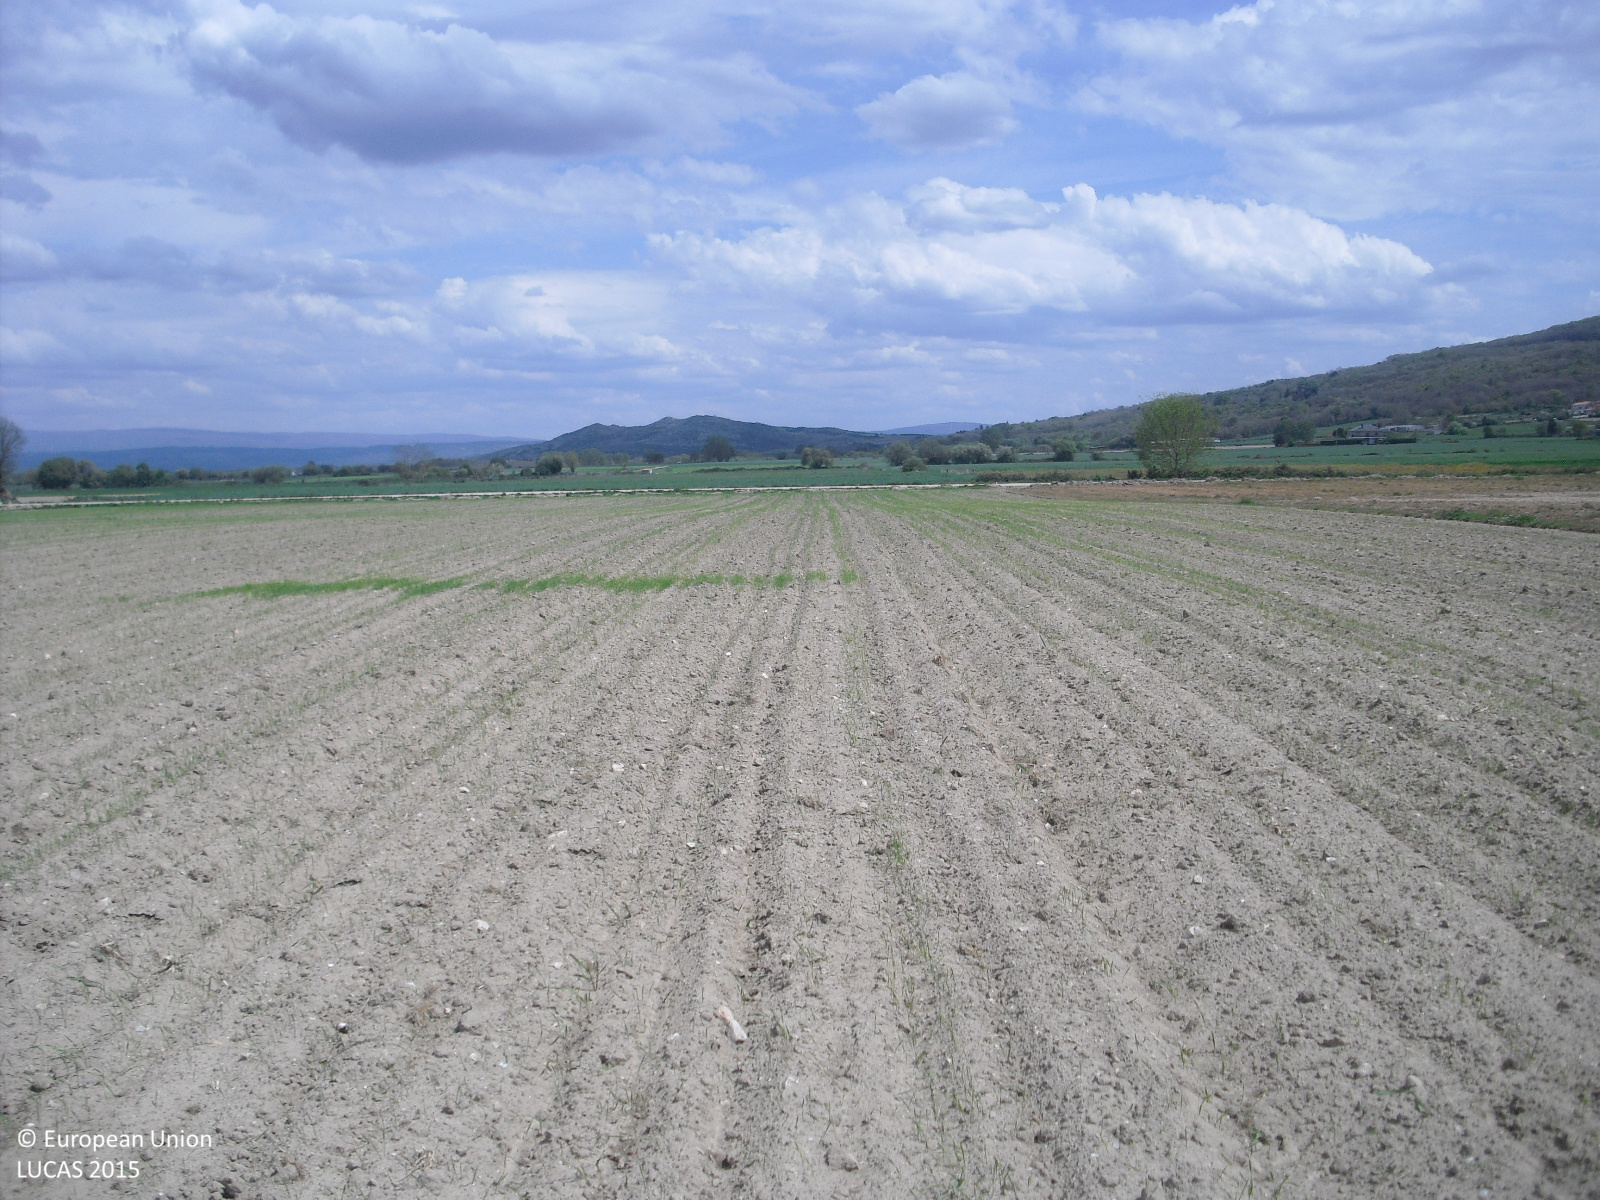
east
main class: Cropland
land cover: Common wheat
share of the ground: < 10 %
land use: Agriculture (excluding fallow land and kitchen gardens)
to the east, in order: Common wheat; Grass margins; Tracks; Grass margins; Rivers and streams; Shruby margins; Rye; Grassland without tree/shrub cover
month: April
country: ES
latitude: 42.0280
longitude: -7.7644
